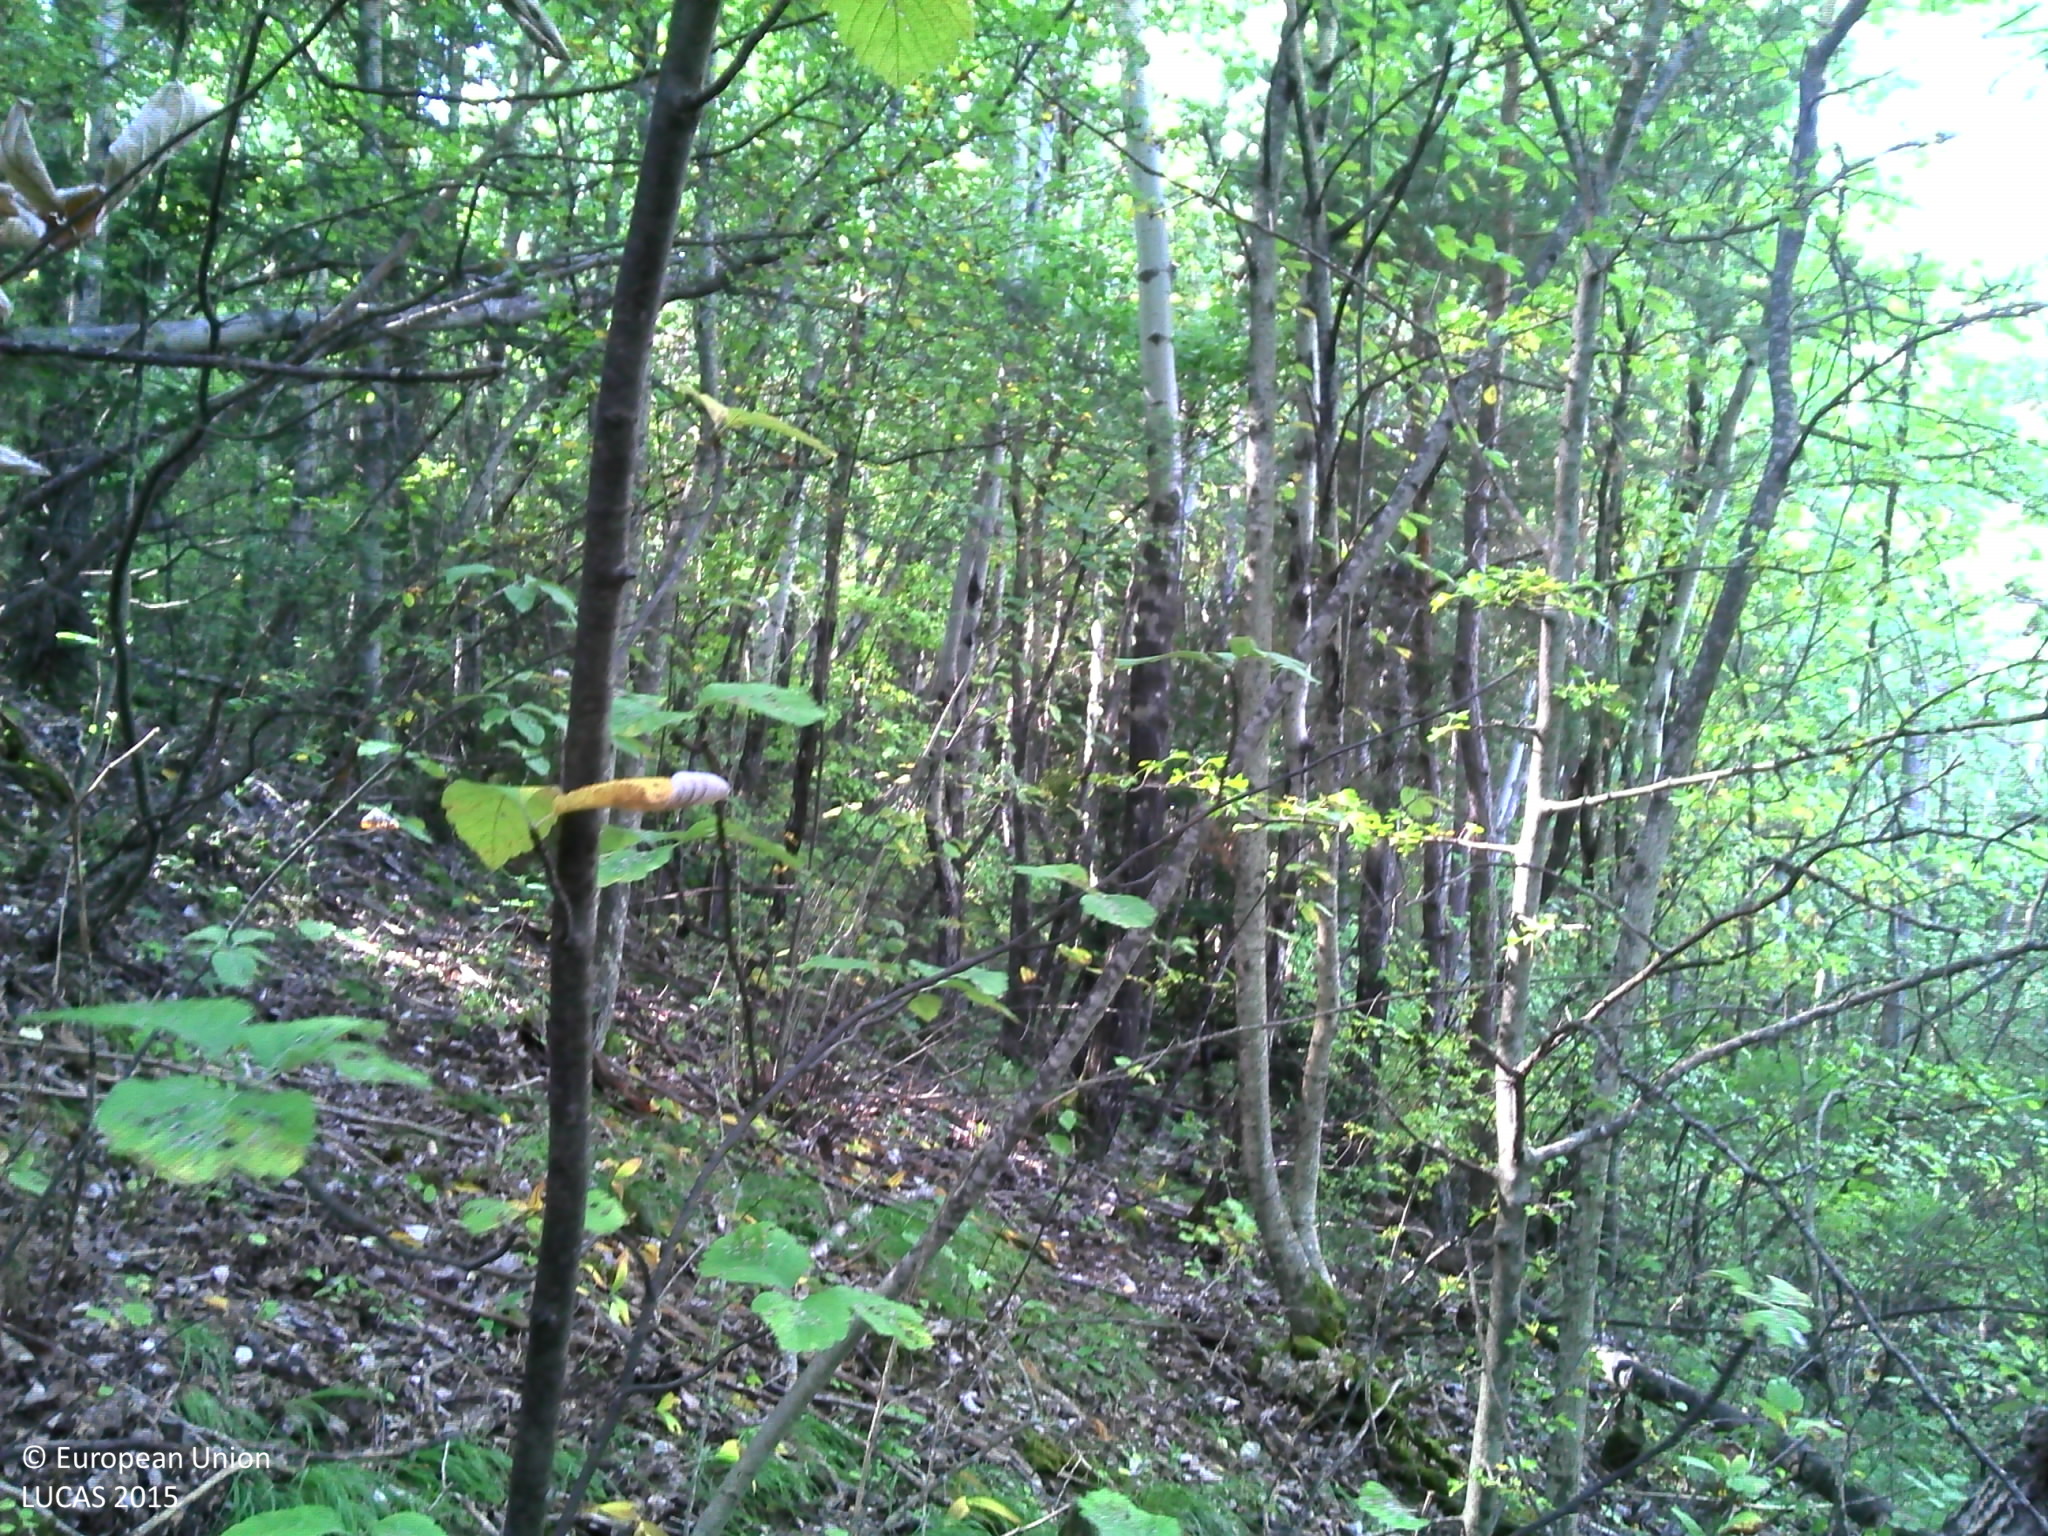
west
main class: Woodland
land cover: Pine dominated mixed woodland
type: hemiboreal forest and nemoral coniferous forest and mixed broadleaved-coniferous forest
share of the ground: > 75 %
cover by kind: coniferous forest trees 60 %, broadleaved forest trees 30 %, herbaceous plants 5 %, unconsolidated bare surface 5 %
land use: Forestry
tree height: > 5 m
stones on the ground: < 10 %
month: September
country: FR
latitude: 44.5235
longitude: 6.4205
